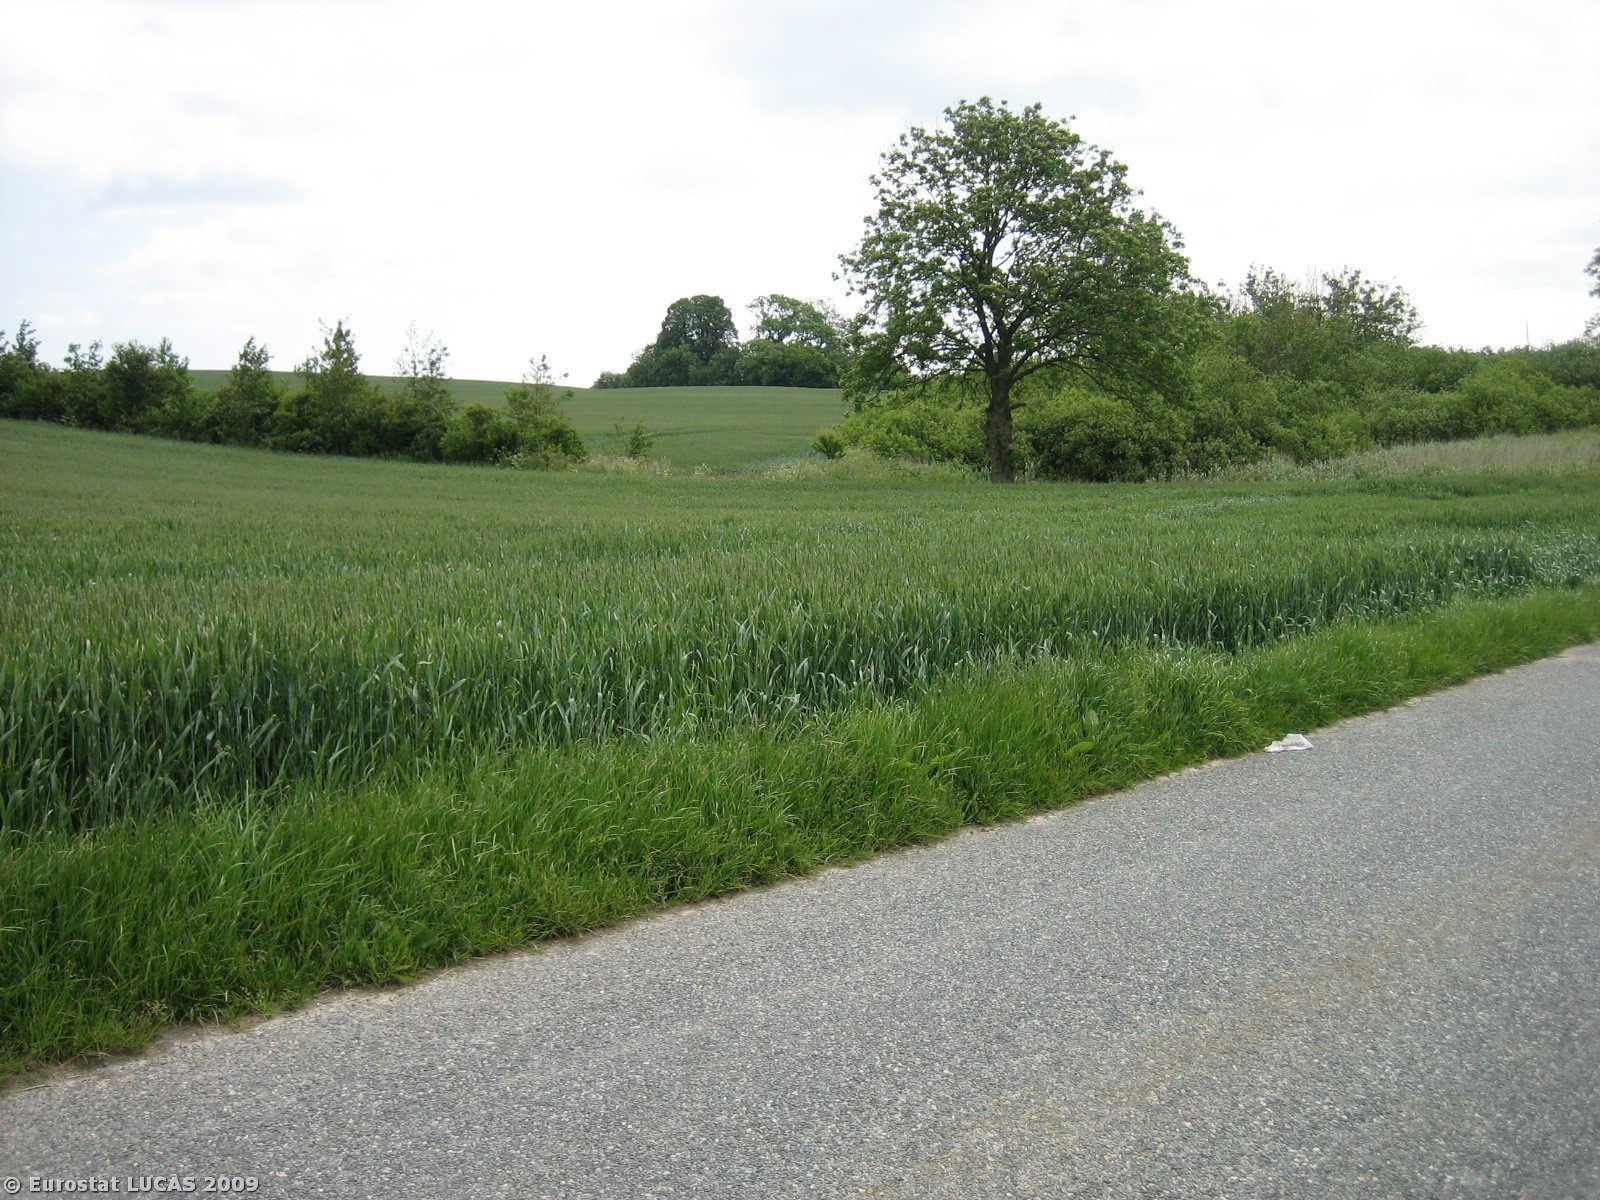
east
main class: Cropland
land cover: Common wheat
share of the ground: > 75 %
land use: Agriculture (excluding fallow land and kitchen gardens)
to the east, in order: Common wheat; Grass margins; Fences; Grass margins; Common wheat; Grass margins
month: June
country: DK
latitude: 55.9361
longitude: 10.0160
